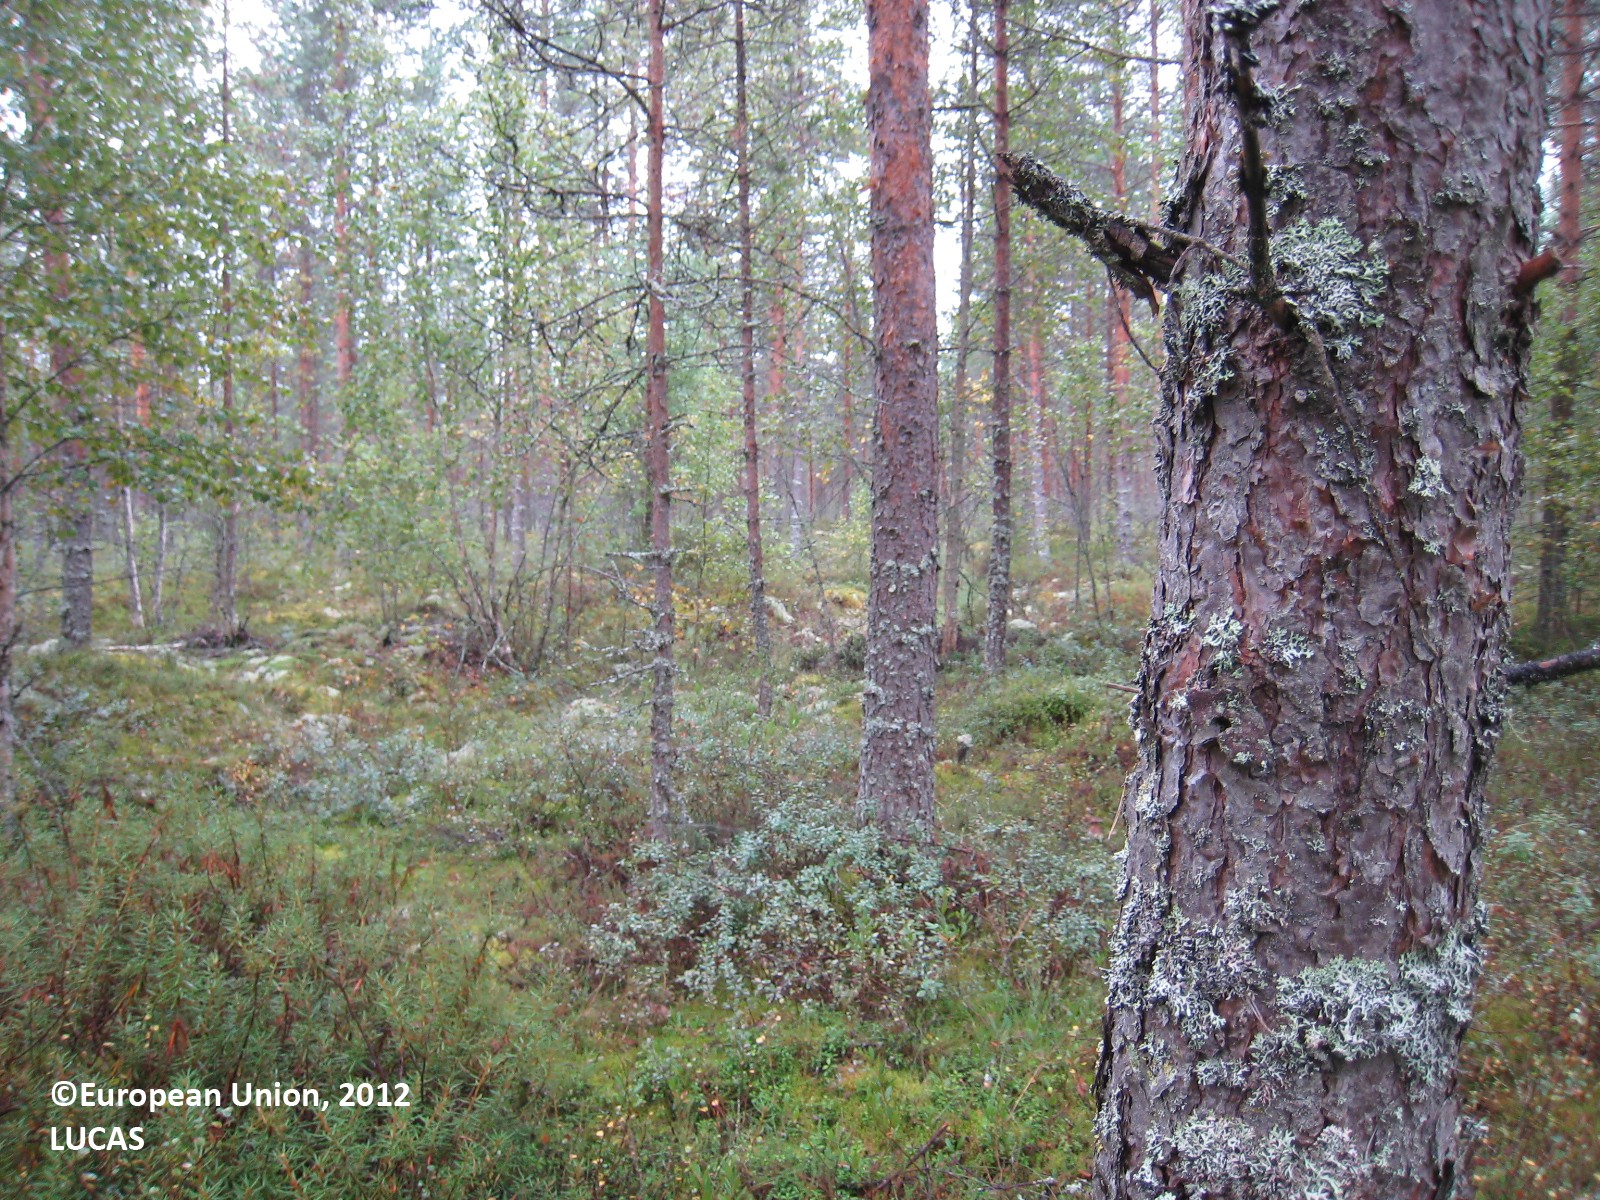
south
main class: Woodland
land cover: Pine dominated coniferous woodland
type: mire and swamp forests
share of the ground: 50 - 75 %
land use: Forestry
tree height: > 5 m
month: August
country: FI
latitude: 61.9083
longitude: 26.2218
